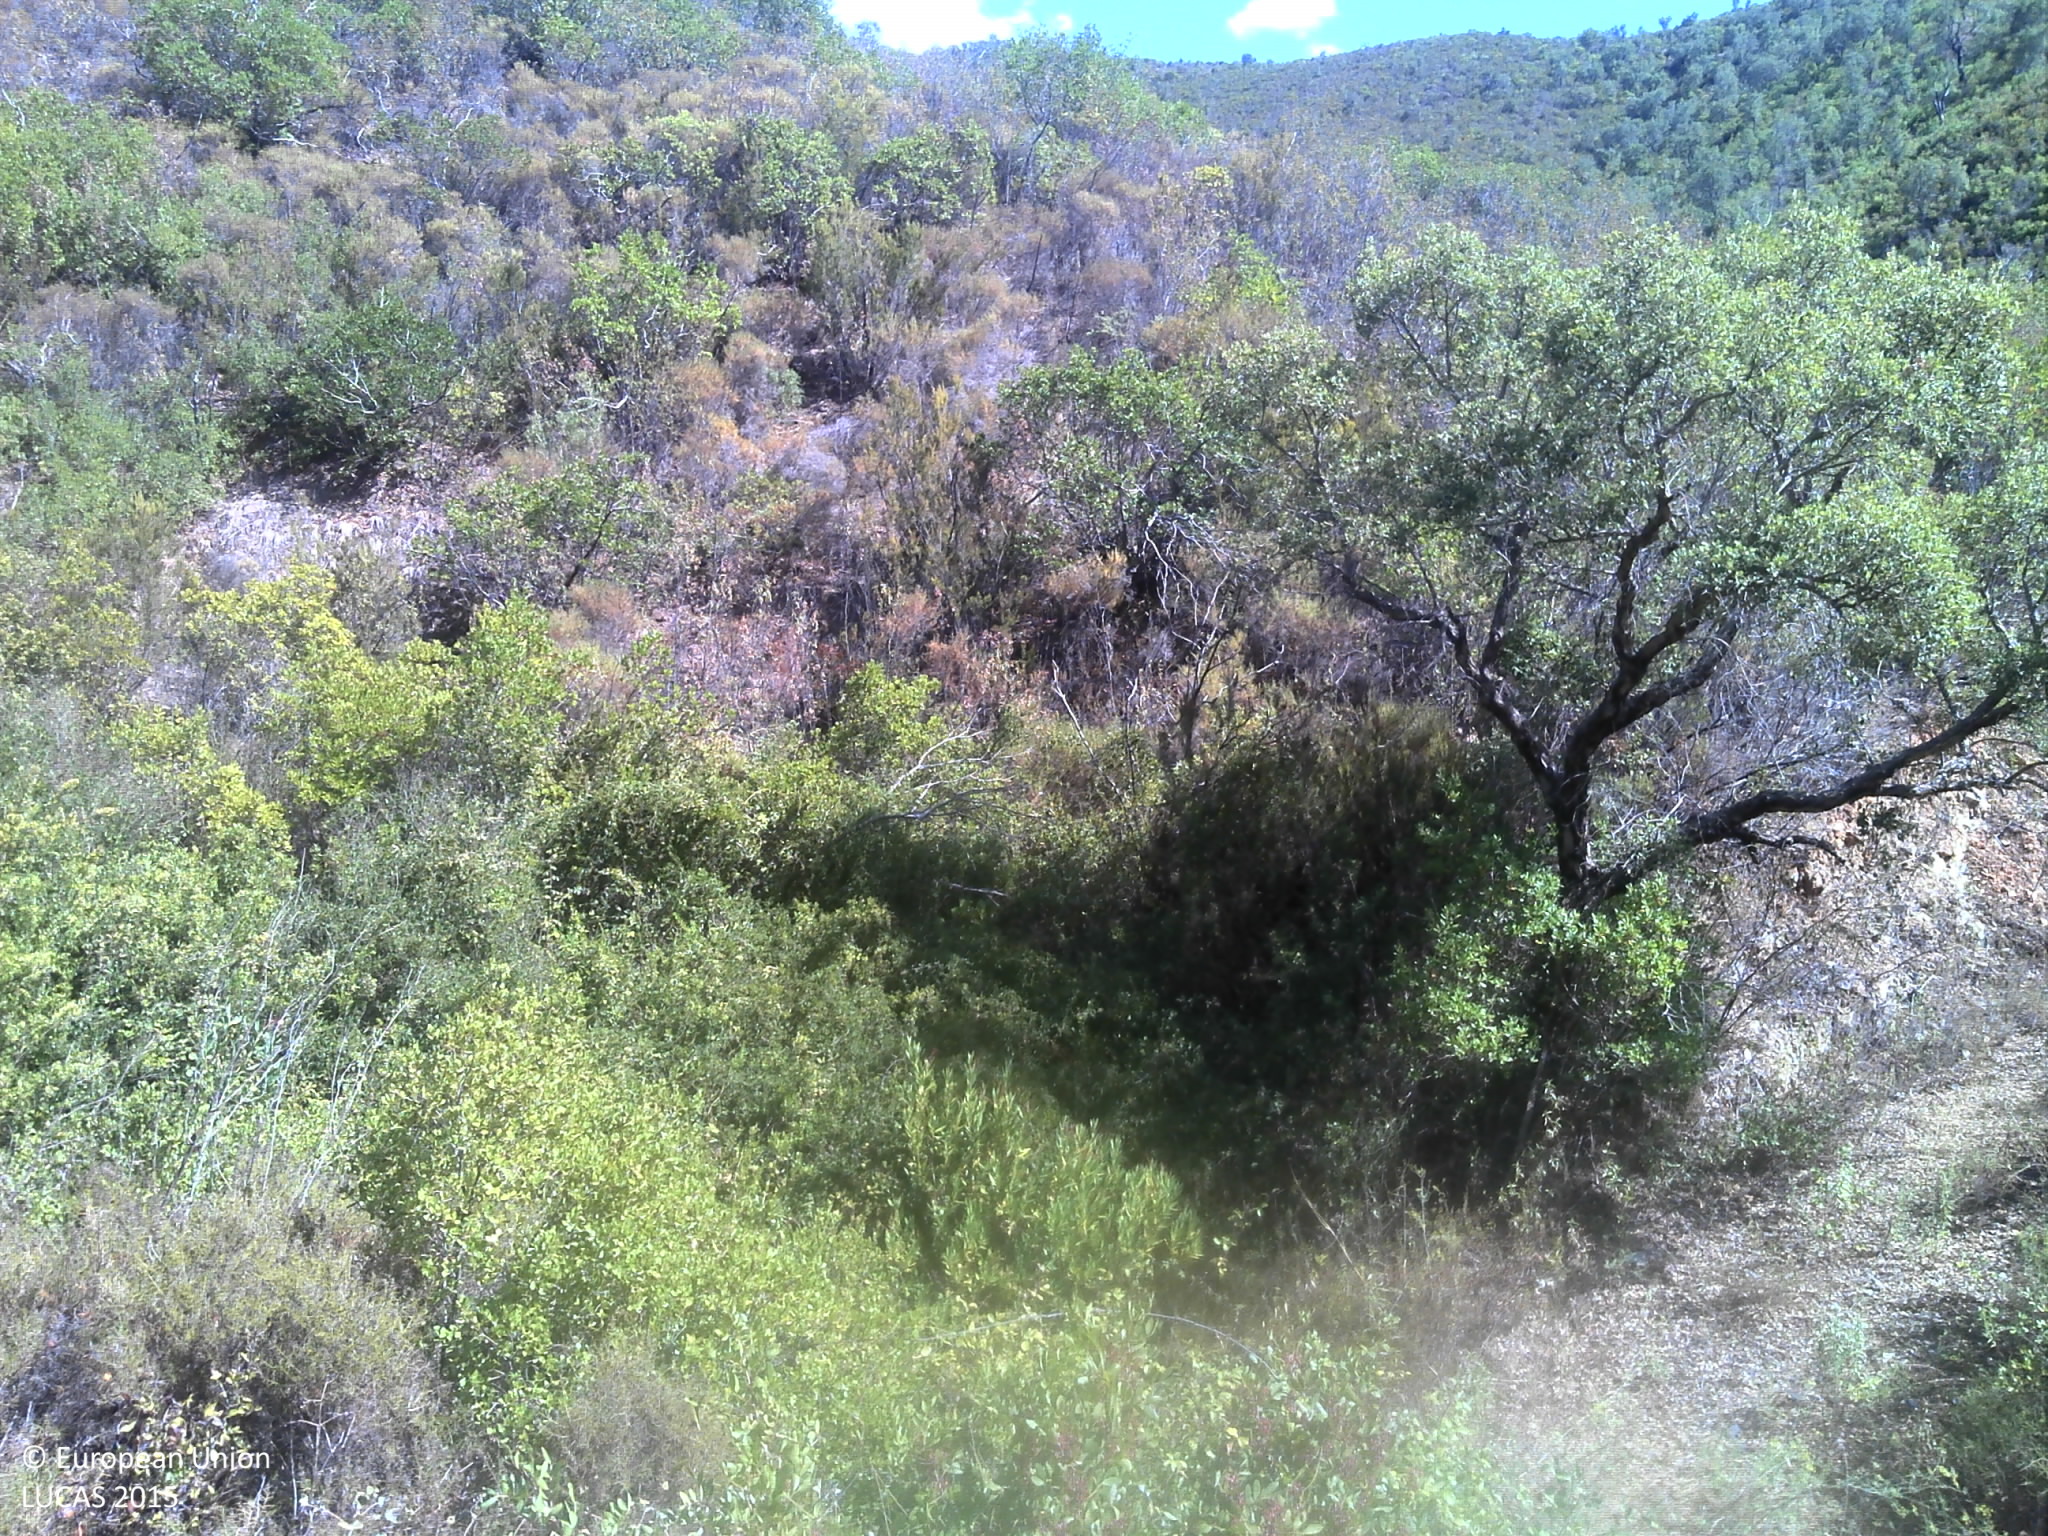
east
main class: Shrubland
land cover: Shrubland without tree cover
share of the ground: 50 - 75 %
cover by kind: shrubs 75 %, unconsolidated bare surface 25 %
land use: Abandoned areas
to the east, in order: Shrubland without tree cover; Tracks; Shrubland with sparse tree cover; Rivers and streams; Shrubland with sparse tree cover; Tracks; Shrubland with sparse tree cover
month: September
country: PT
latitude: 37.3402
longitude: -8.2292
